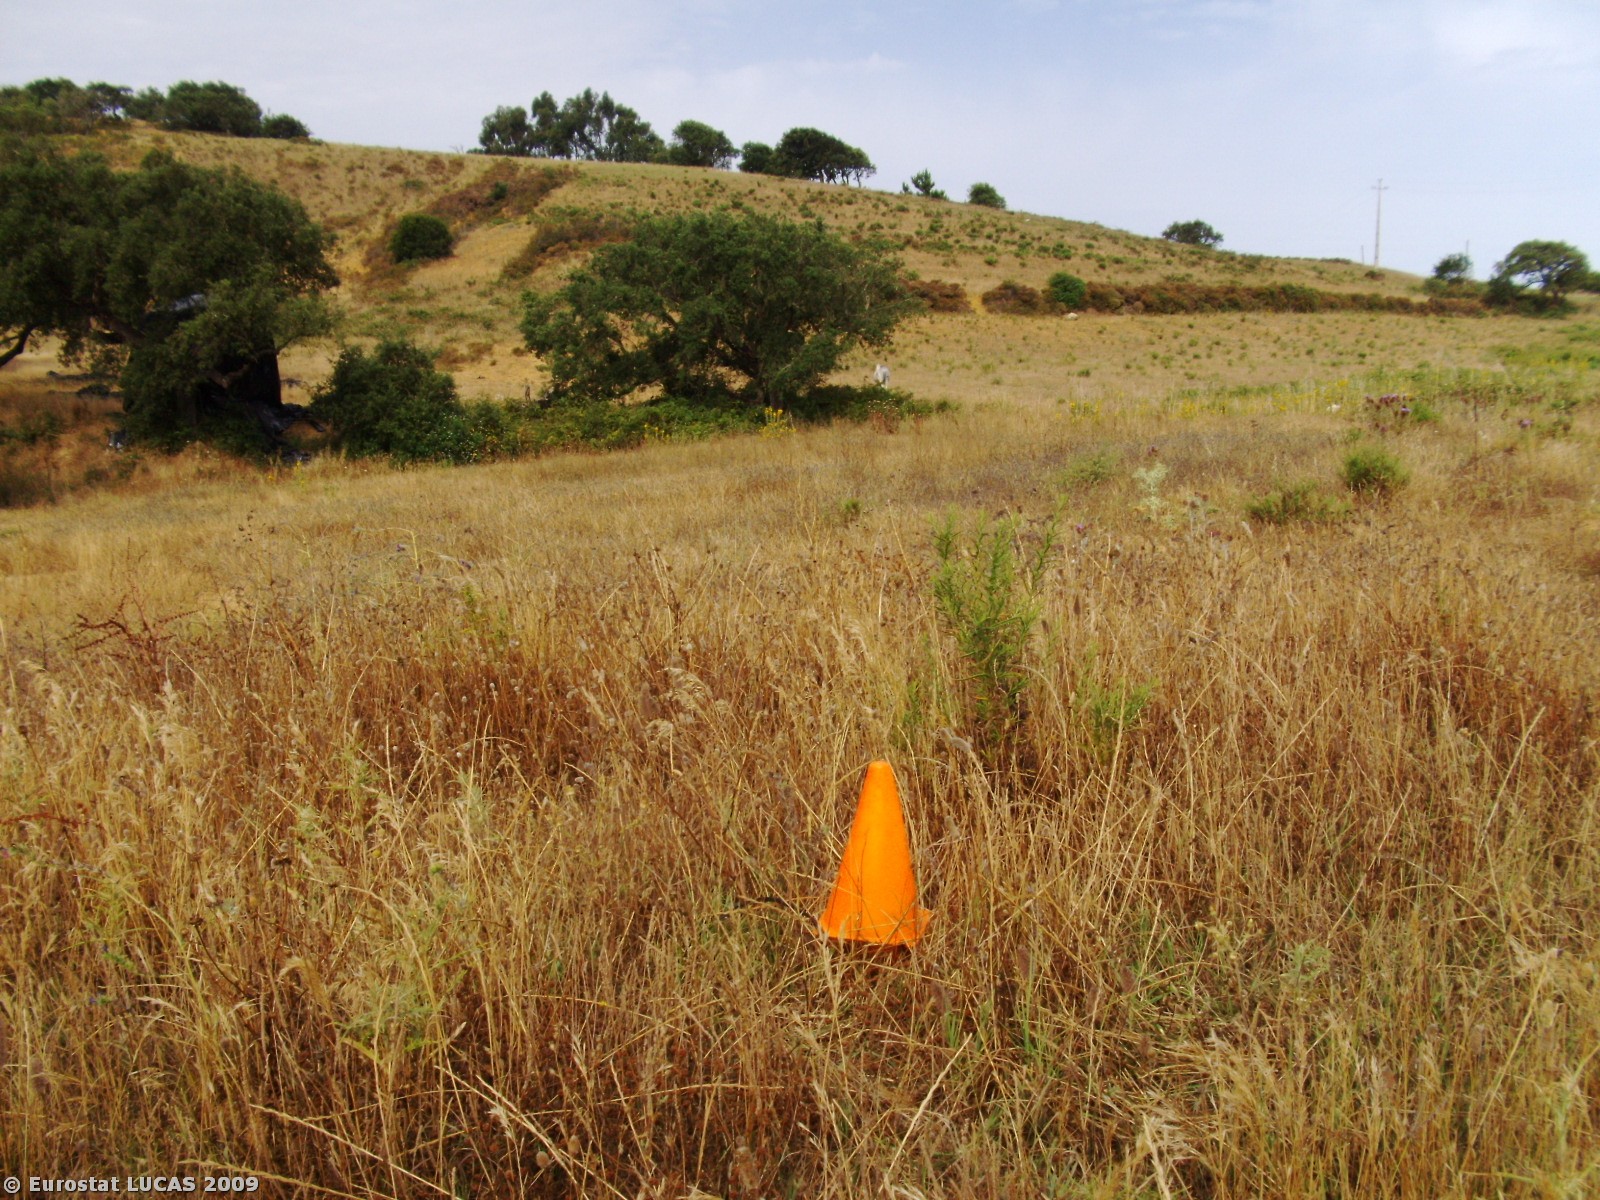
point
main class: Grassland
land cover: Spontaneously vegetated surfaces
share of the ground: > 75 %
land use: Fallow land
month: June
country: PT
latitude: 37.3411
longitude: -8.7850
